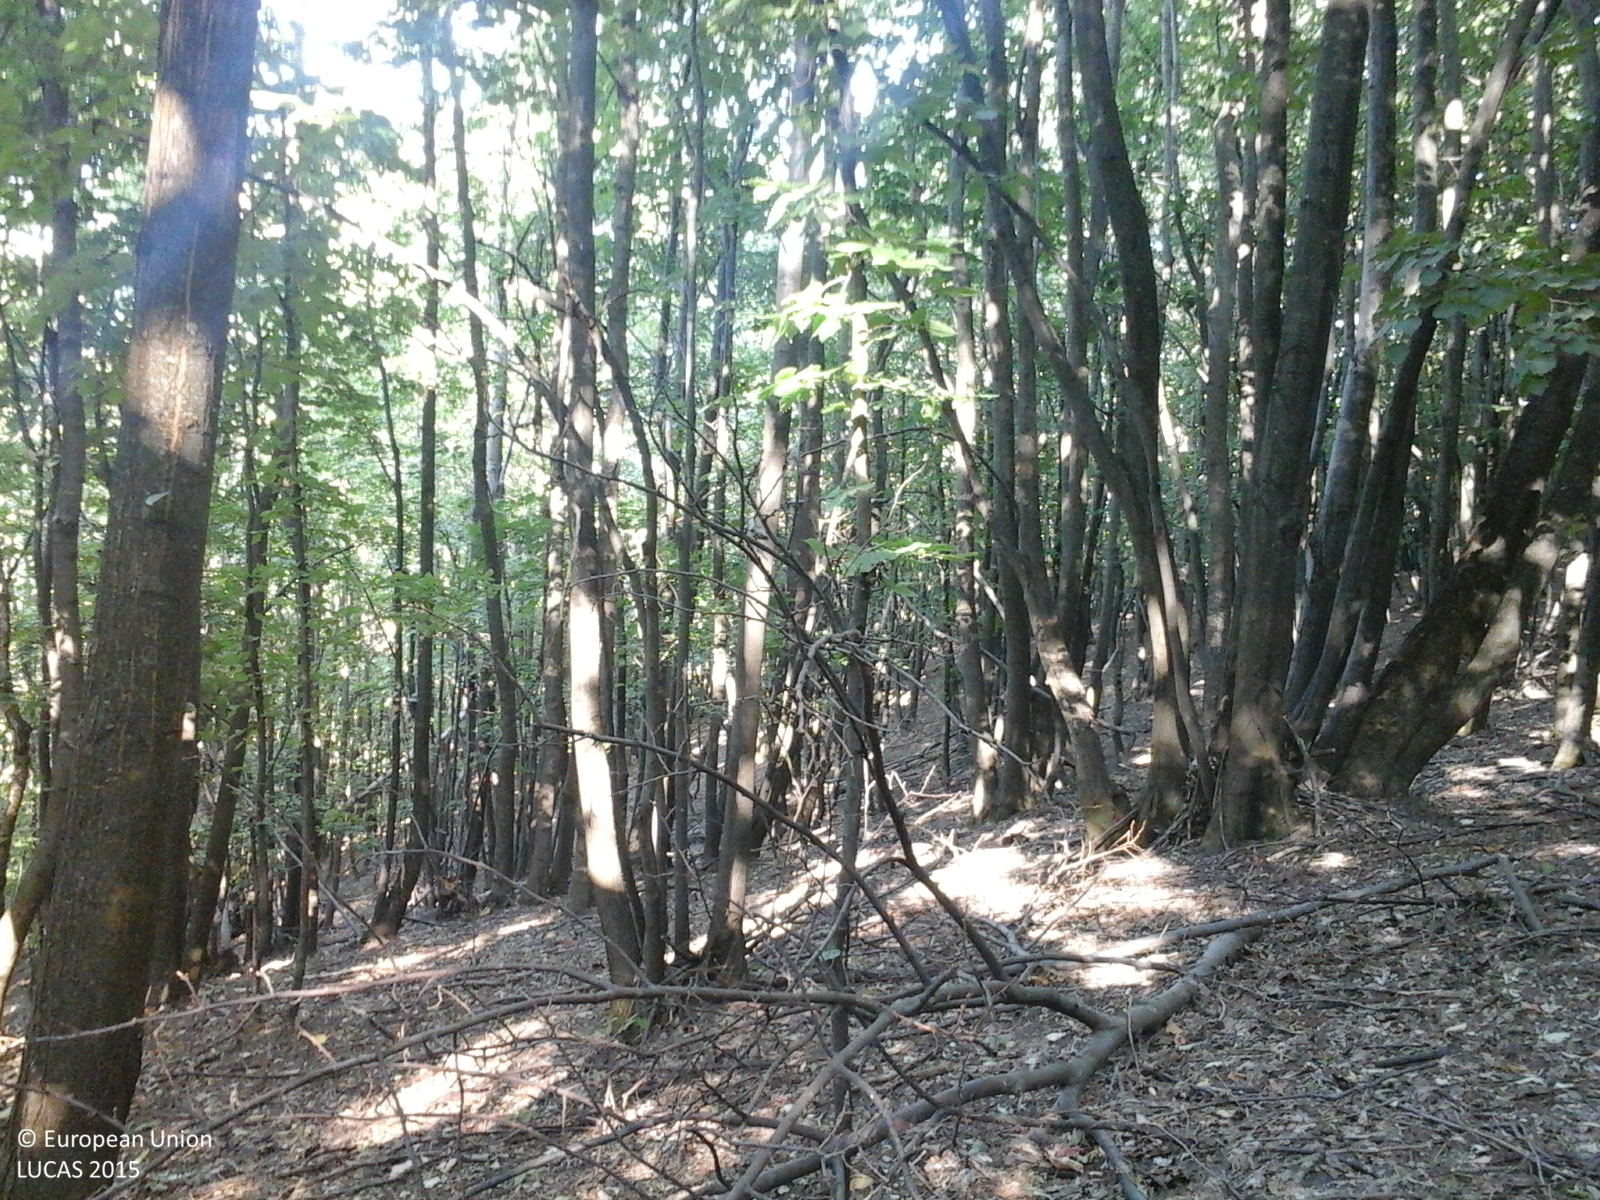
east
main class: Woodland
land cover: Broadleaved woodland
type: mesophytic deciduous forest
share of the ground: > 75 %
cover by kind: broadleaved forest trees 100 %
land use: Forestry
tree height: > 5 m
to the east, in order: Broadleaved woodland; Tracks; Broadleaved woodland; Grassland without tree/shrub cover
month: June
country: RO
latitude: 46.9445
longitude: 27.9020
